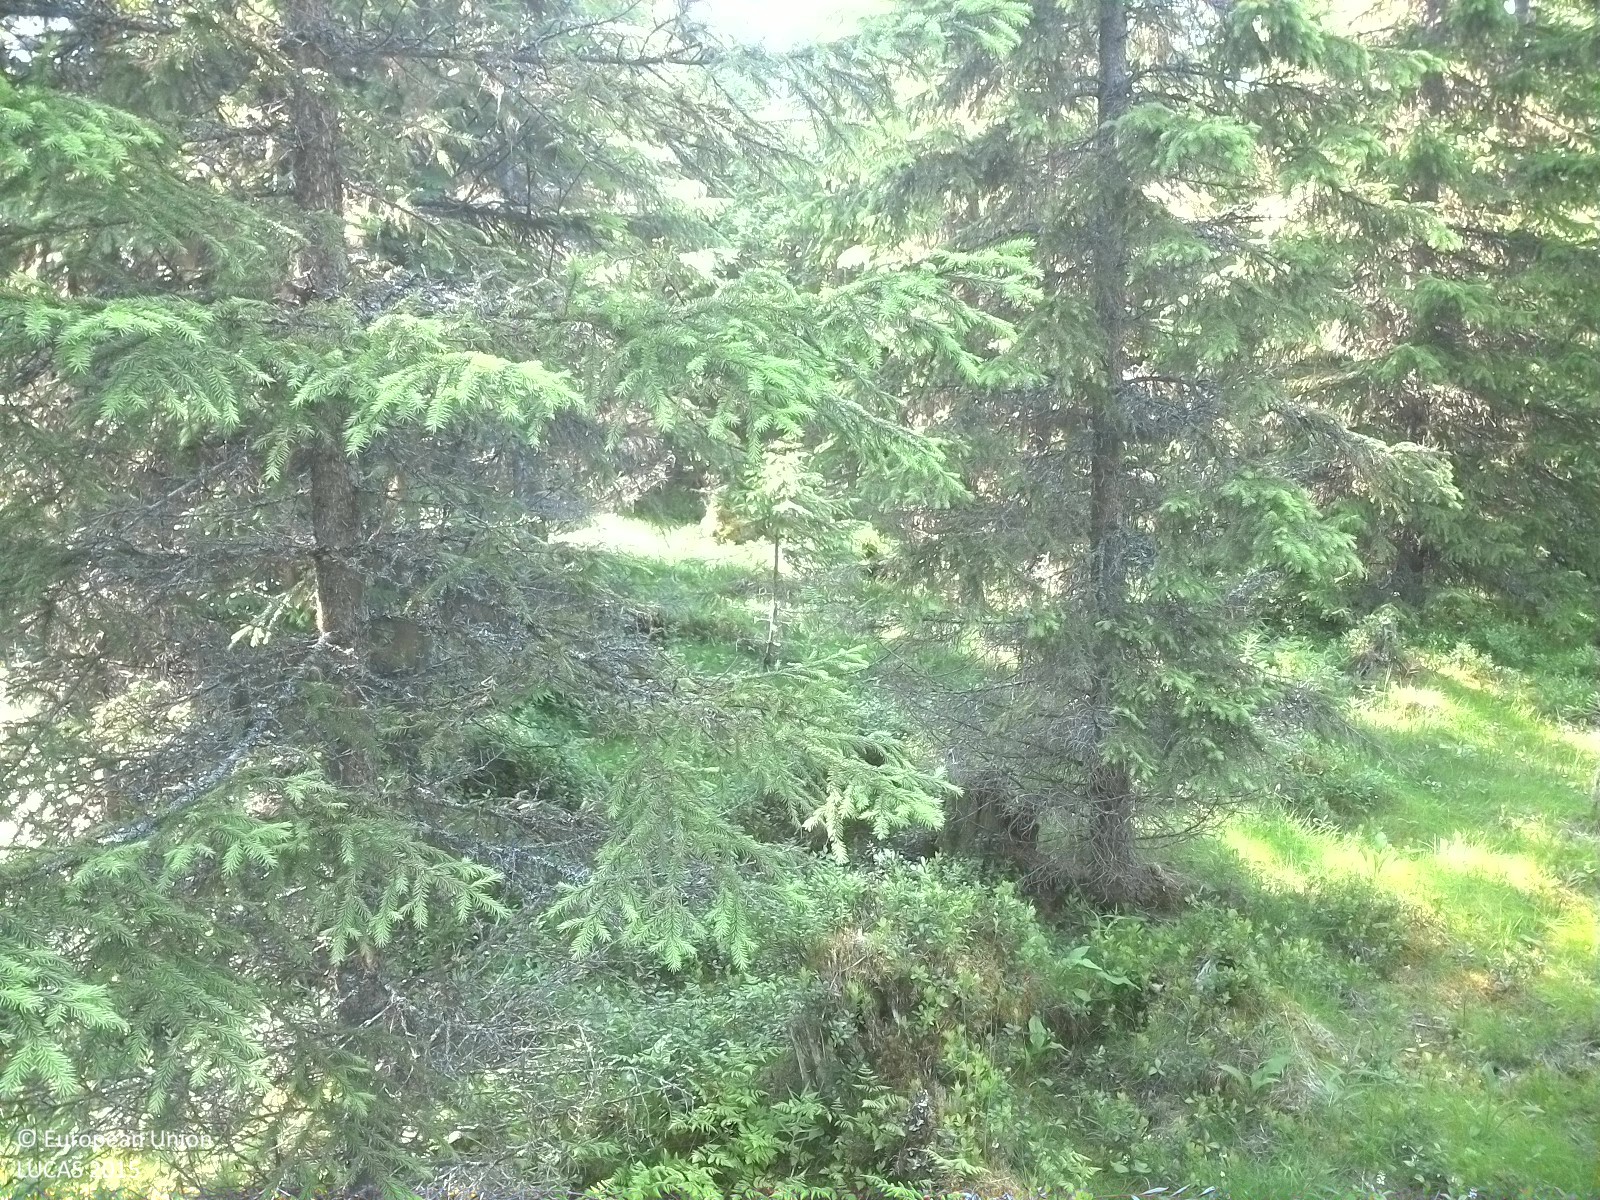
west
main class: Woodland
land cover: Spruce dominated coniferous woodland
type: boreal forest
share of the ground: 50 - 75 %
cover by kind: coniferous forest trees 75 %, shrubs 25 %
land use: Forestry
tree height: > 5 m
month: July
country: SE
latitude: 63.5934
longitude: 15.0746
